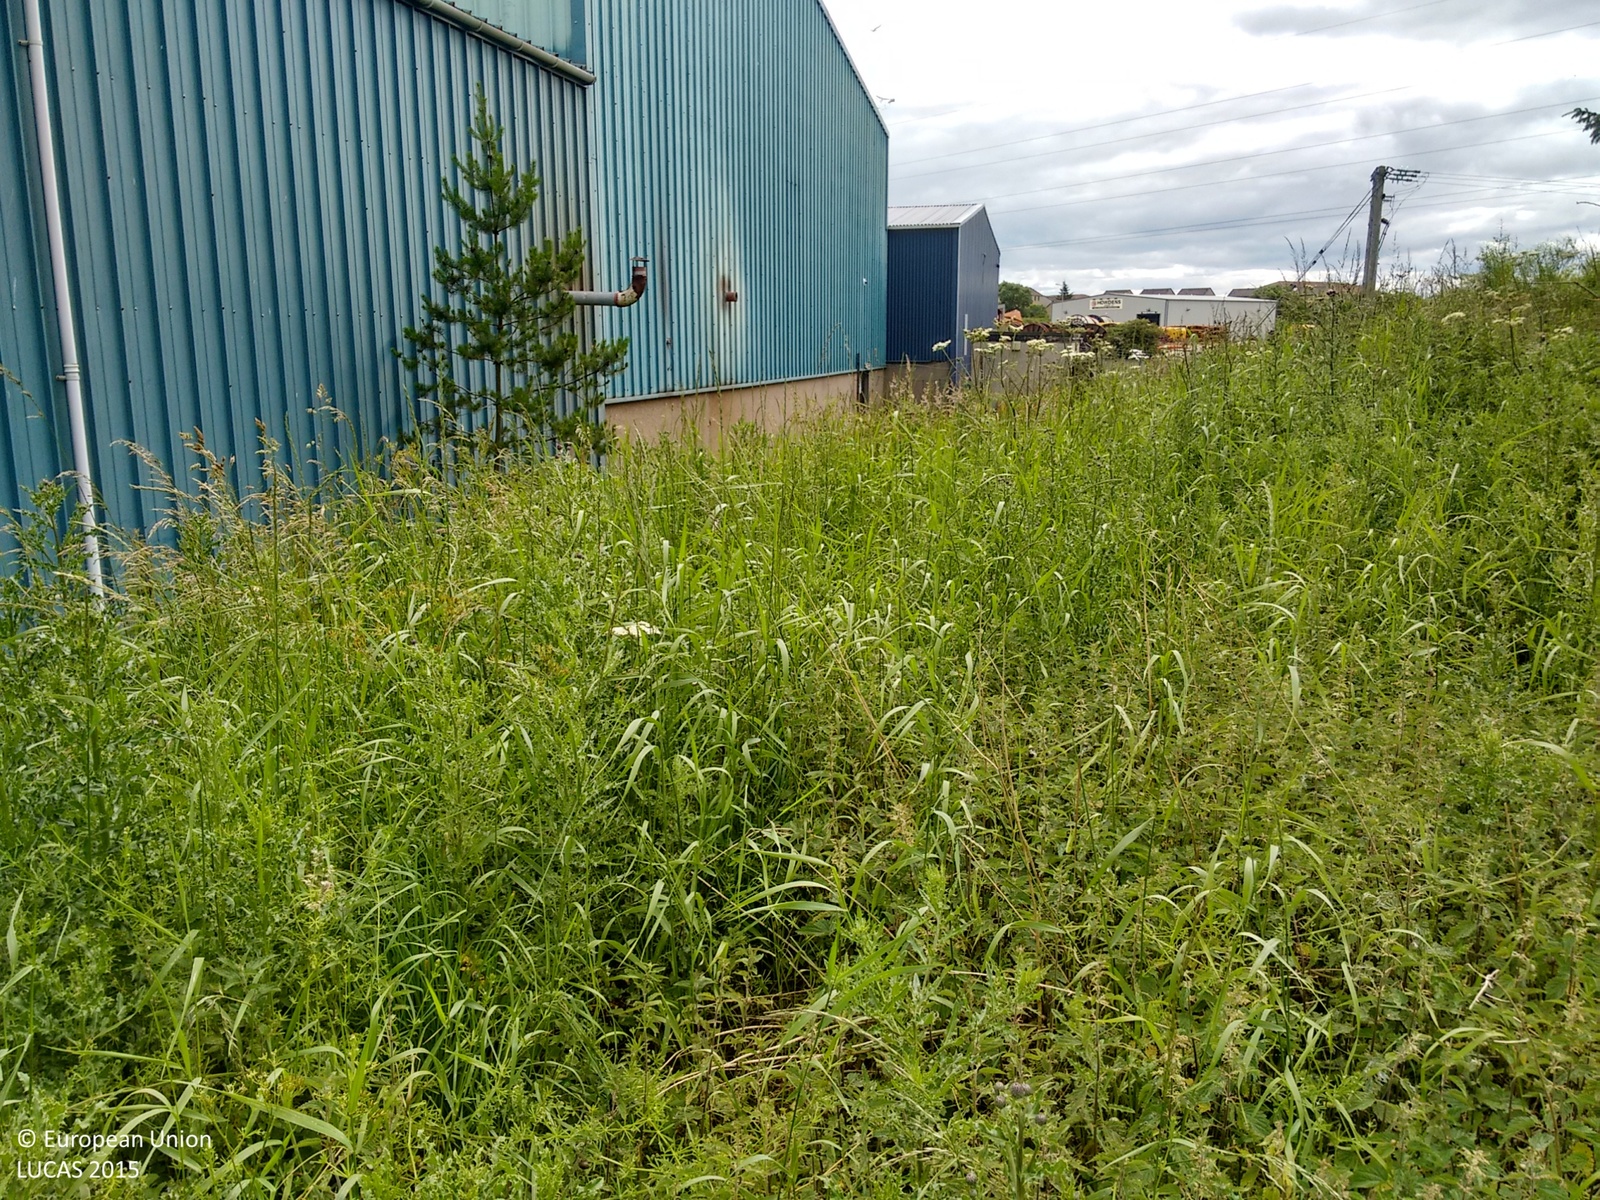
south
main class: Grassland
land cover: Grassland with sparse tree/shrub cover
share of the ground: > 75 %
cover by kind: herbaceous plants 90 %, broadleaved forest trees 5 %, shrubs 5 %
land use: Semi-natural and natural areas not in use
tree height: > 5 m
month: July
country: GB
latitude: 57.5145
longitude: -1.8114
